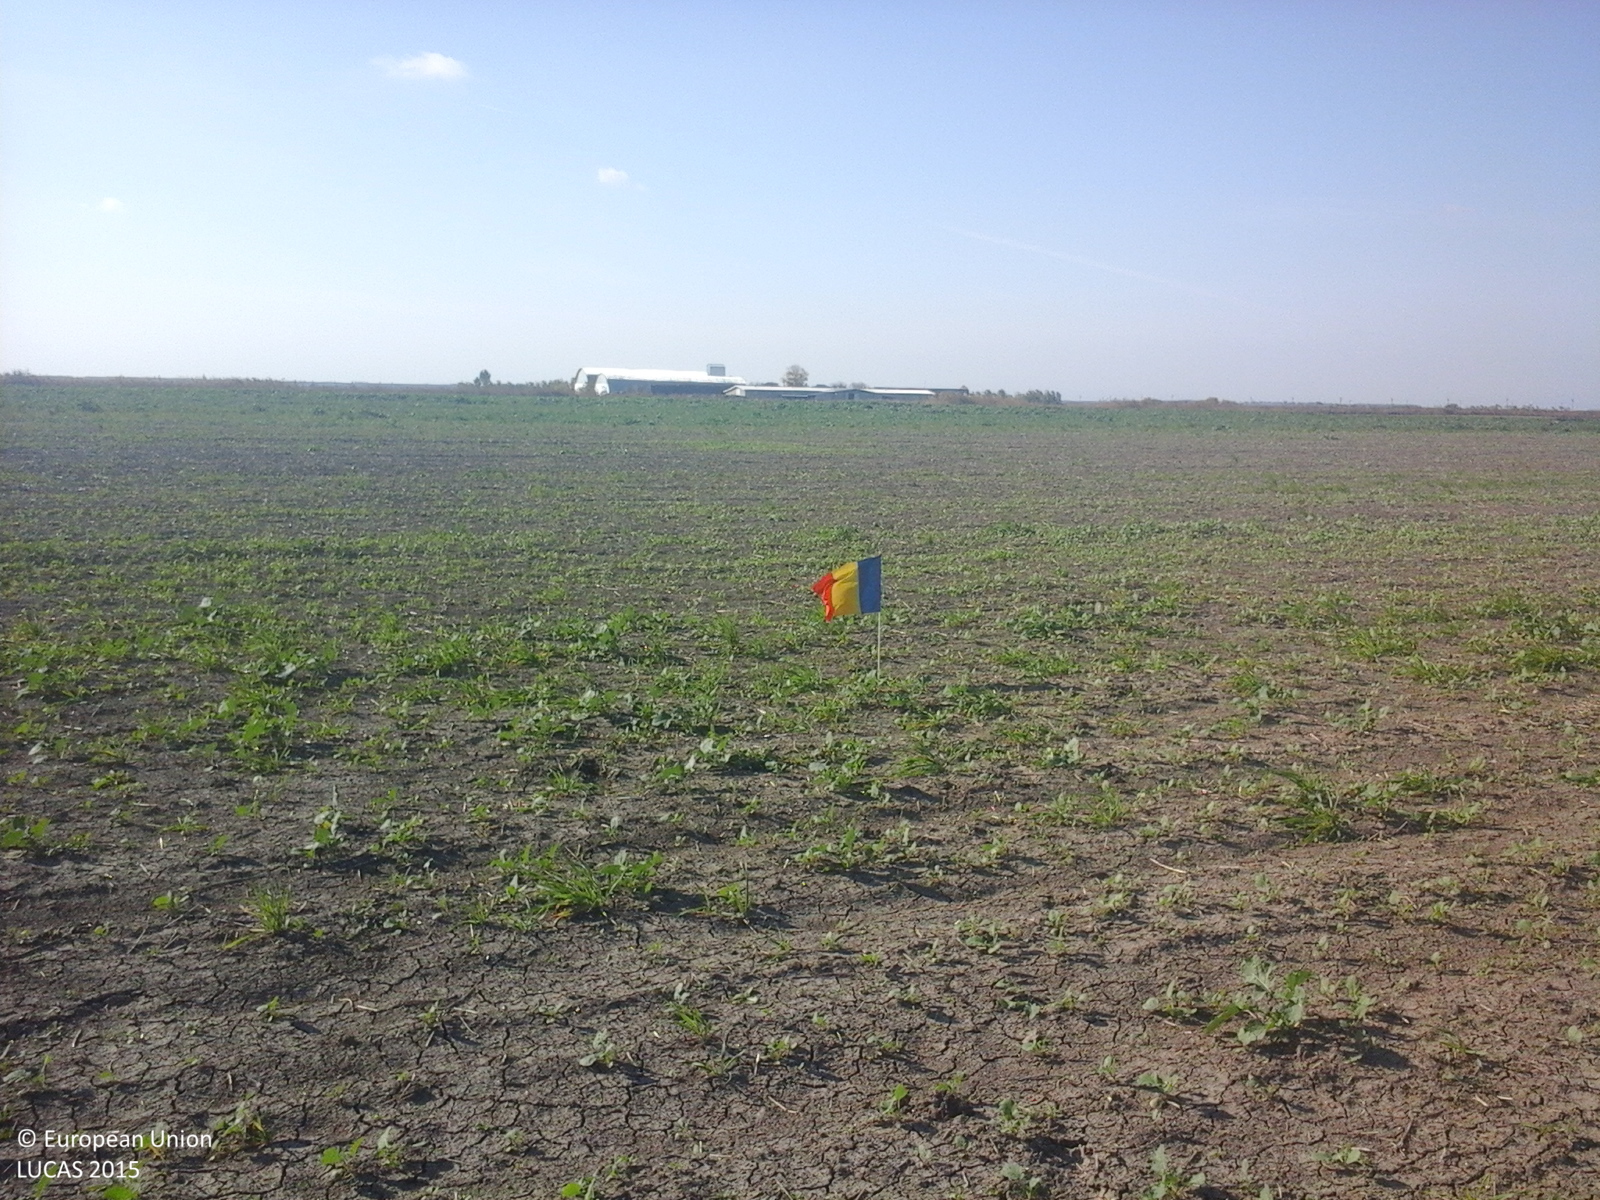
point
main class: Cropland
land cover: Common wheat
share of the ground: < 10 %
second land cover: Spontaneously vegetated surfaces
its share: 25 - 50 %
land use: Agriculture (excluding fallow land and kitchen gardens)
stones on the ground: < 10 %
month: October
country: RO
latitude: 45.3369
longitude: 27.4937
